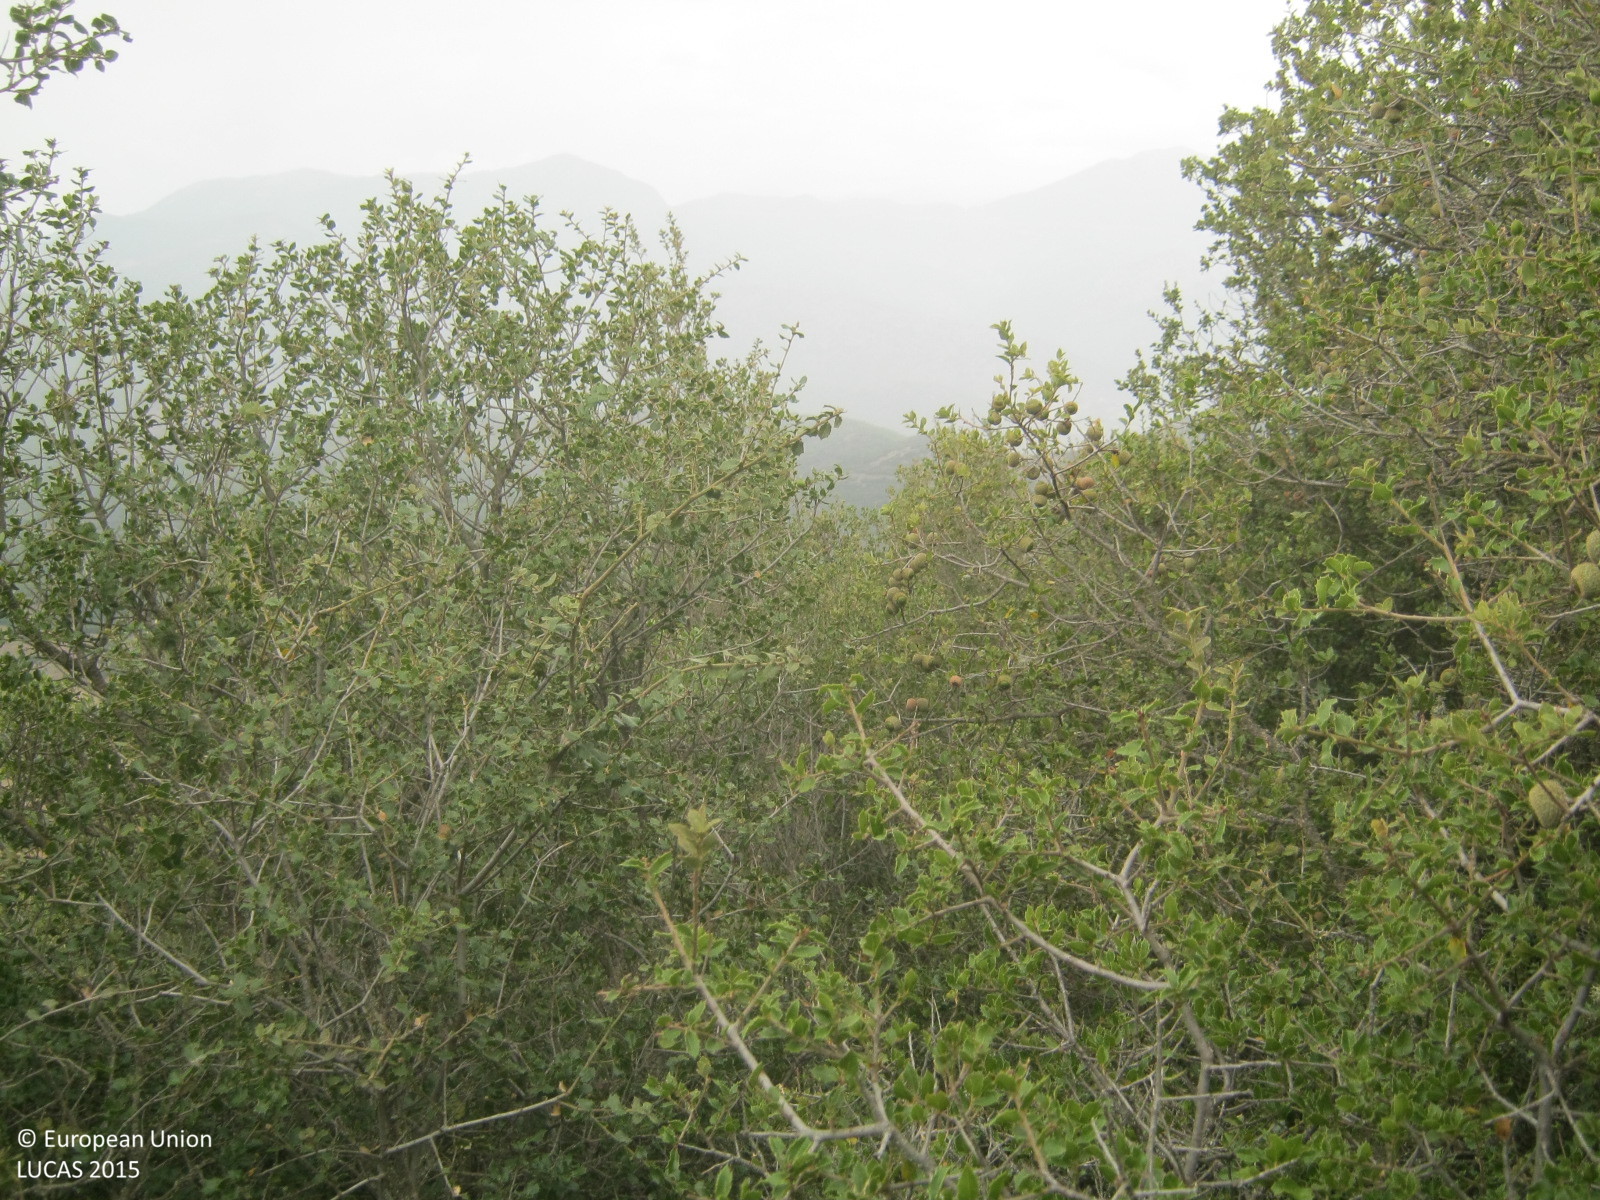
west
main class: Shrubland
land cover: Shrubland with sparse tree cover
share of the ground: > 75 %
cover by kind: shrubs 85 %, broadleaved forest trees 5 %, herbaceous plants 5 %, unconsolidated bare surface 5 %
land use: Semi-natural and natural areas not in use
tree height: > 5 m
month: September
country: GR
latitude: 37.8671
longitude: 22.1168
